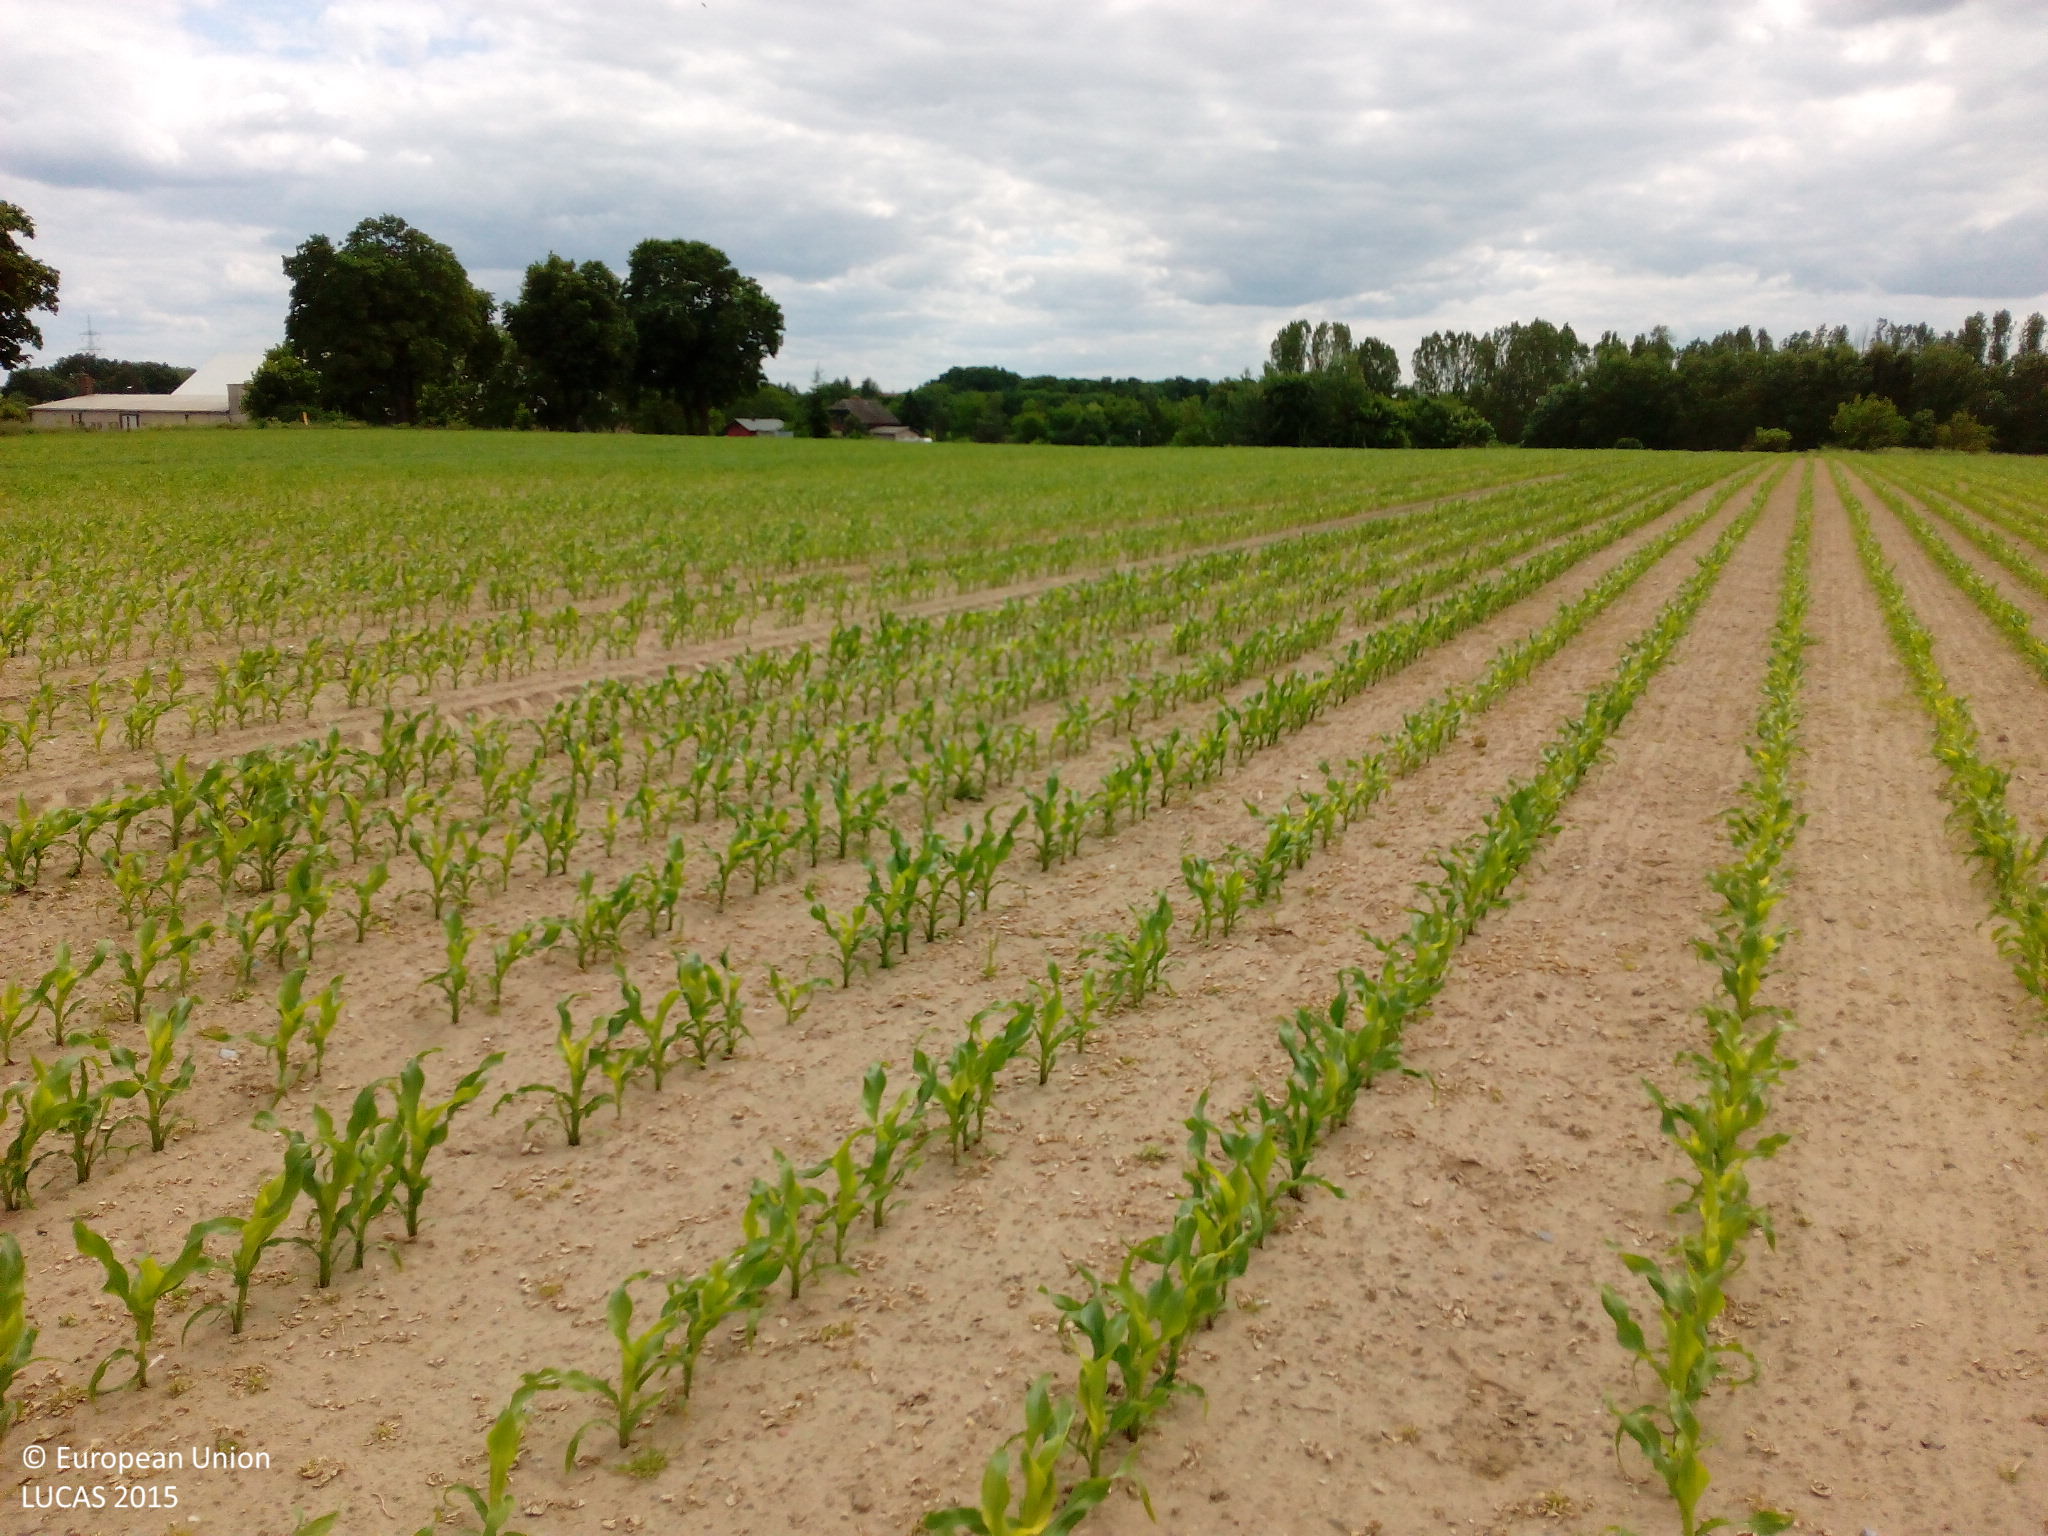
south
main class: Cropland
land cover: Maize
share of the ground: < 10 %
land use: Agriculture (excluding fallow land and kitchen gardens)
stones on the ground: < 10 %
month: June
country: DE
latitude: 53.3610
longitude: 12.3585
